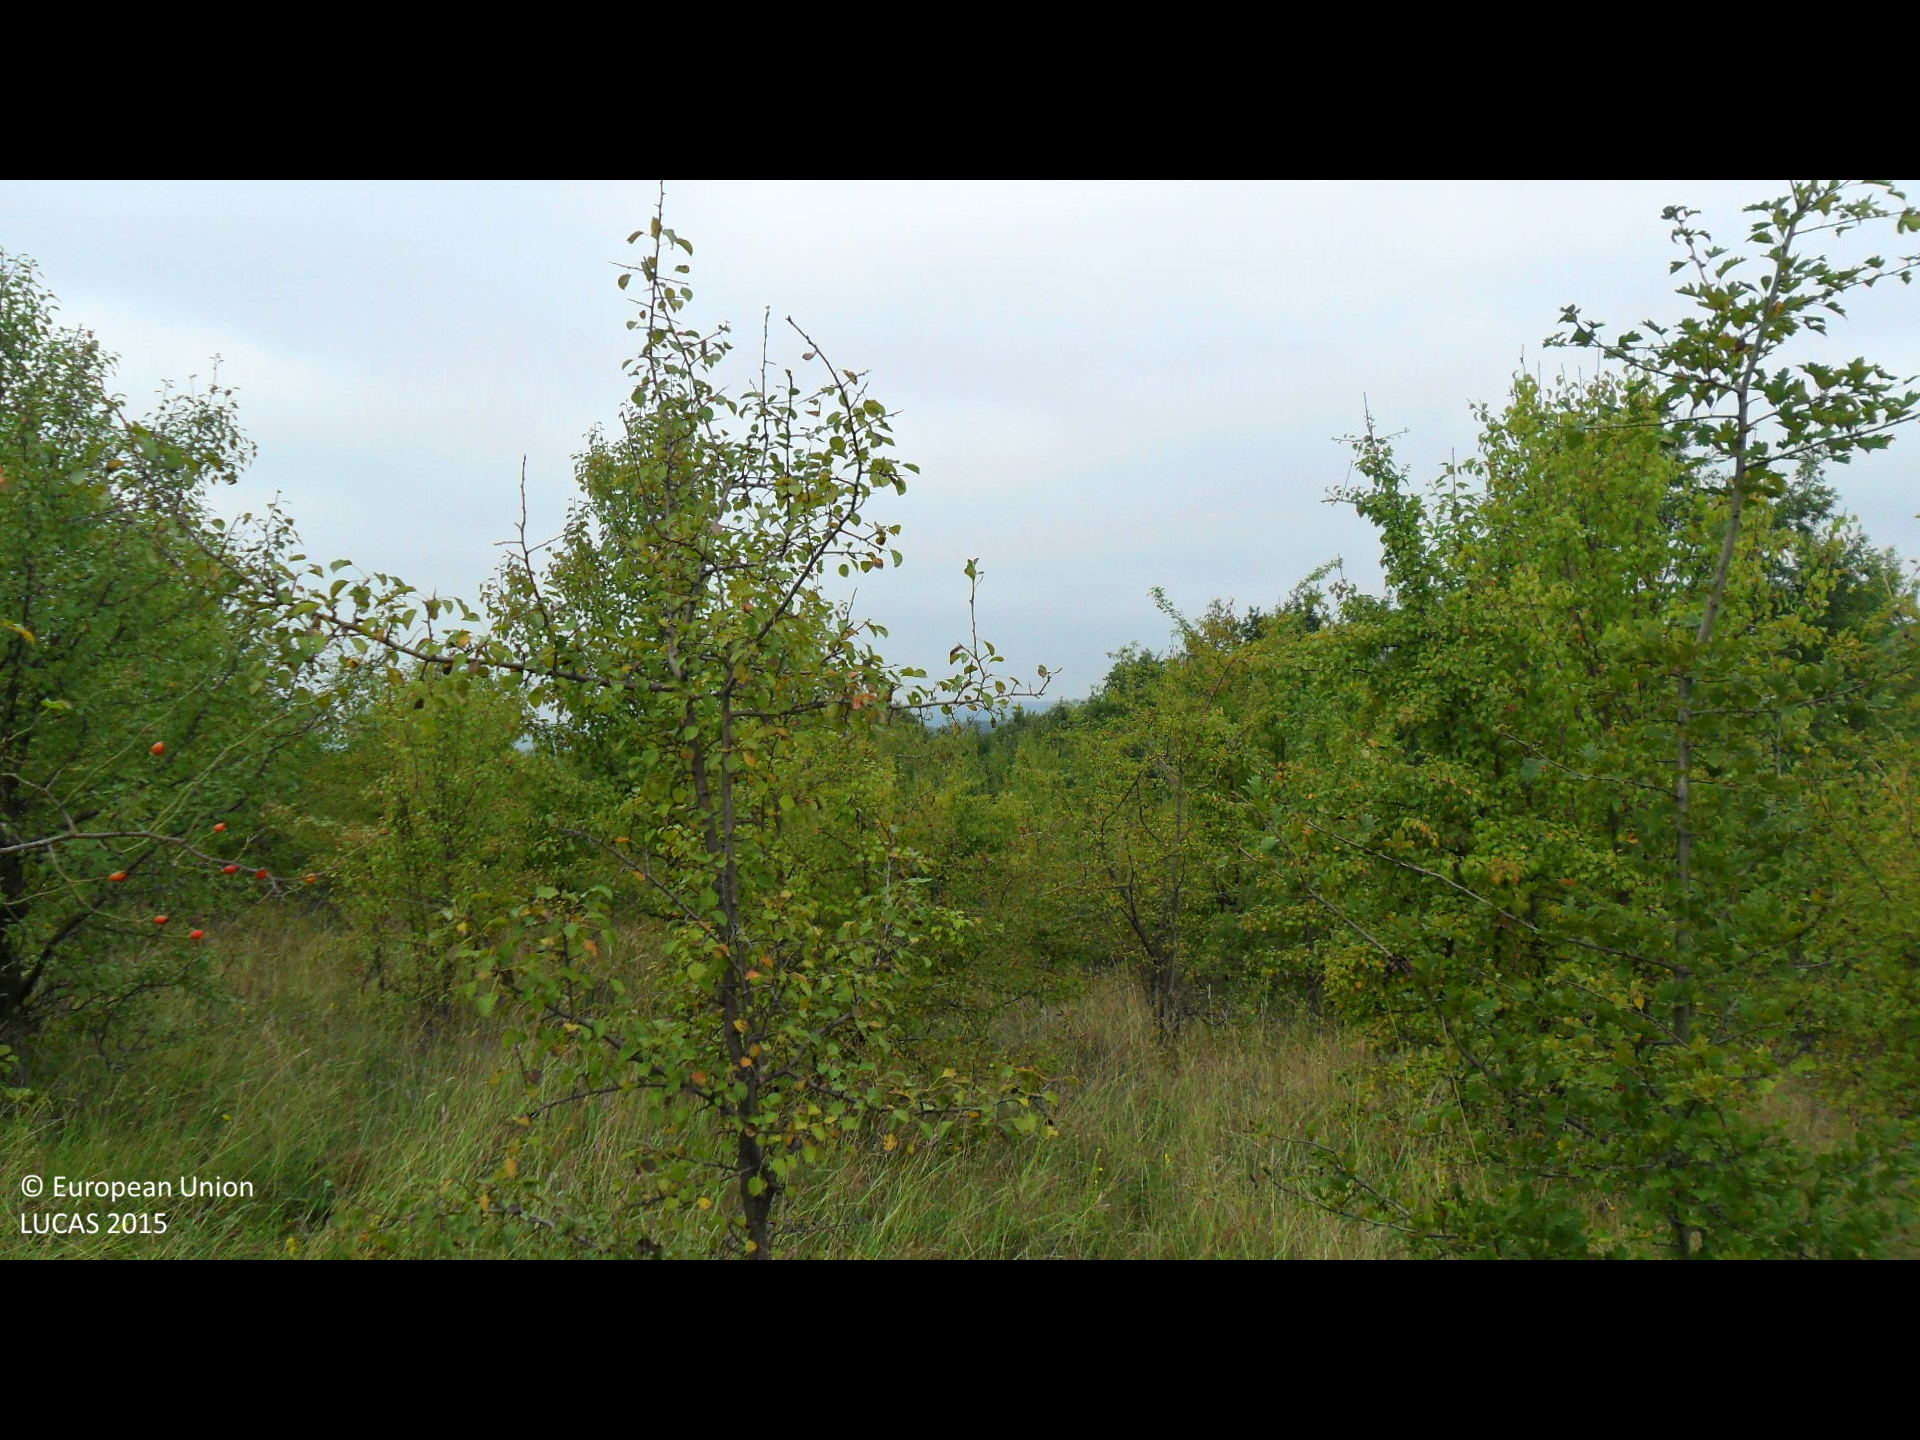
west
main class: Grassland
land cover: Grassland with sparse tree/shrub cover
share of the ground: > 75 %
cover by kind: herbaceous plants 90 %, broadleaved forest trees 5 %, shrubs 5 %
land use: Semi-natural and natural areas not in use
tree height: < 5 m
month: September
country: BG
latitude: 43.2676
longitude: 26.0964
